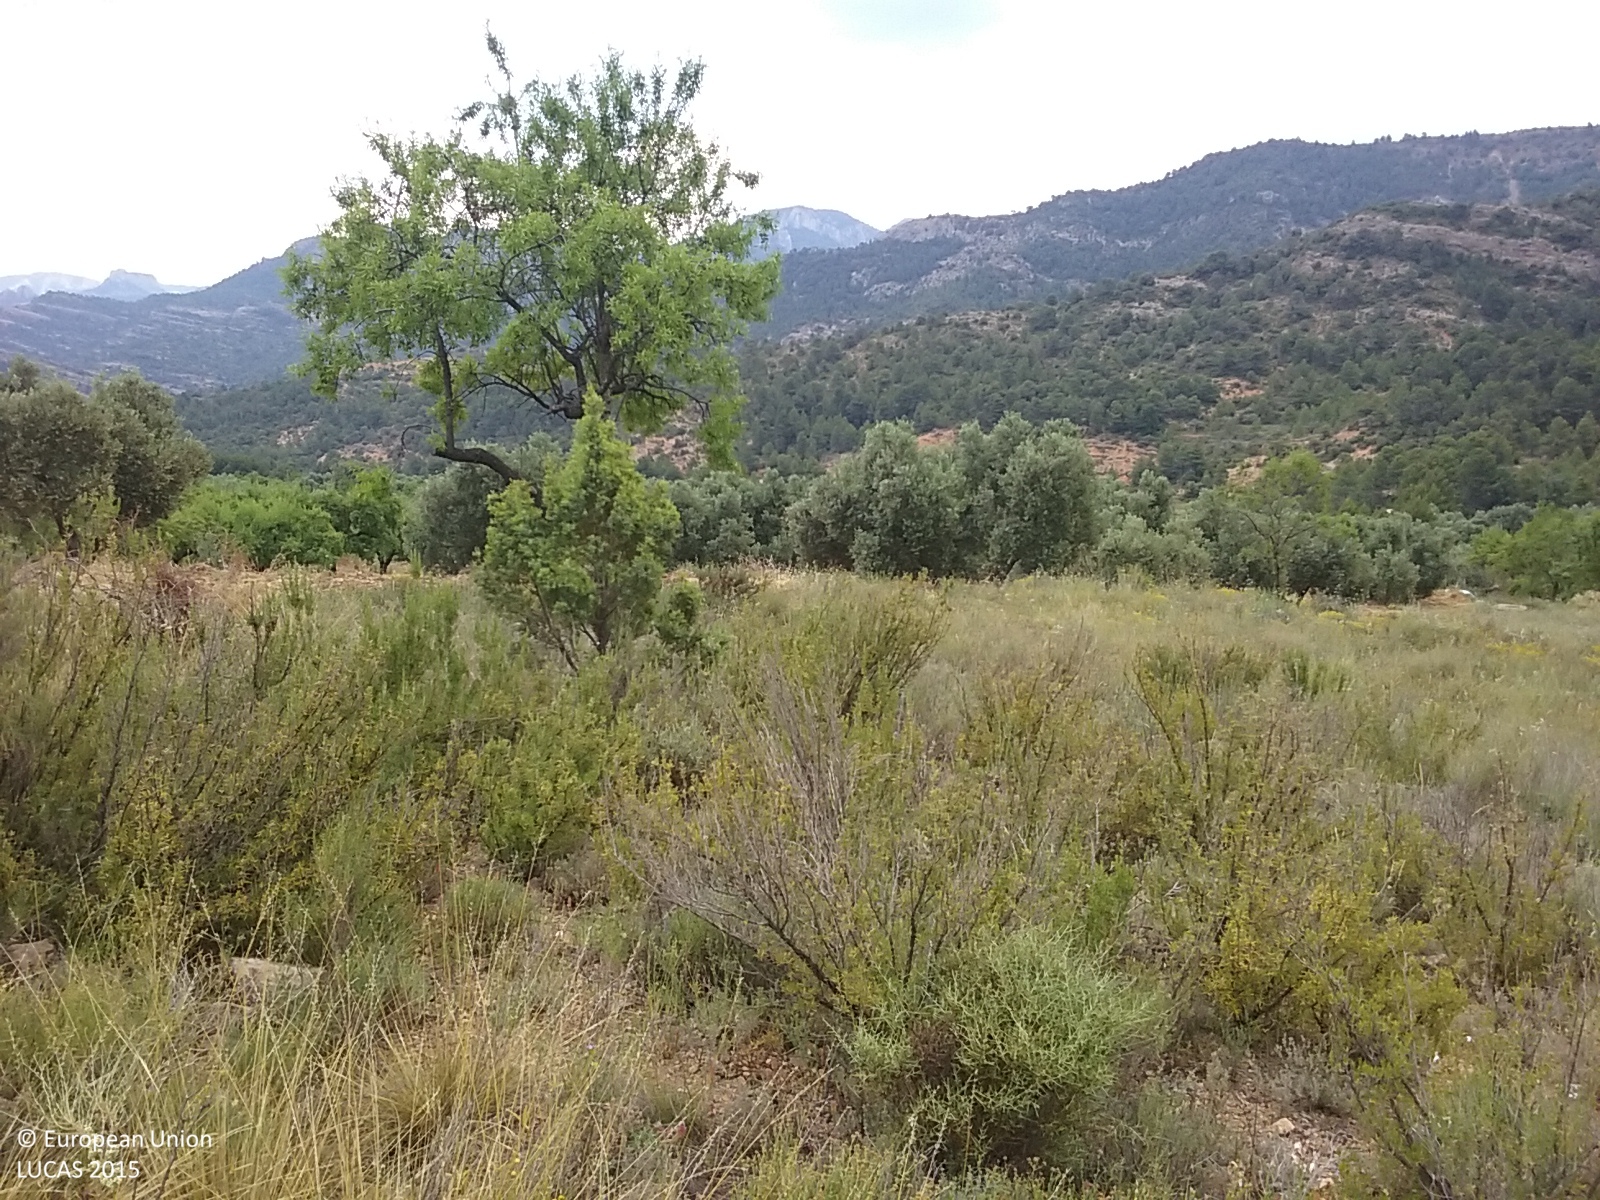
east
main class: Shrubland
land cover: Shrubland without tree cover
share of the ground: 10 - 25 %
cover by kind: herbaceous plants 80 %, shrubs 20 %
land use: Abandoned areas
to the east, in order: Dry stone walls; Shrubland without tree cover; Nuts trees; Olive groves; Shrubland with sparse tree cover; Nuts trees; Shrubland with sparse tree cover; Nuts trees; Dry stone walls; Nuts trees; Olive groves; Grass margins; Olive groves; Dry stone walls; Spontaneously vegetated surfaces; Pine dominated coniferous woodland; Grass margins; Tracks; Dry stone walls; Paved roads, cycling and walking lanes; Nuts trees
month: June
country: ES
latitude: 40.8278
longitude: 0.1621
